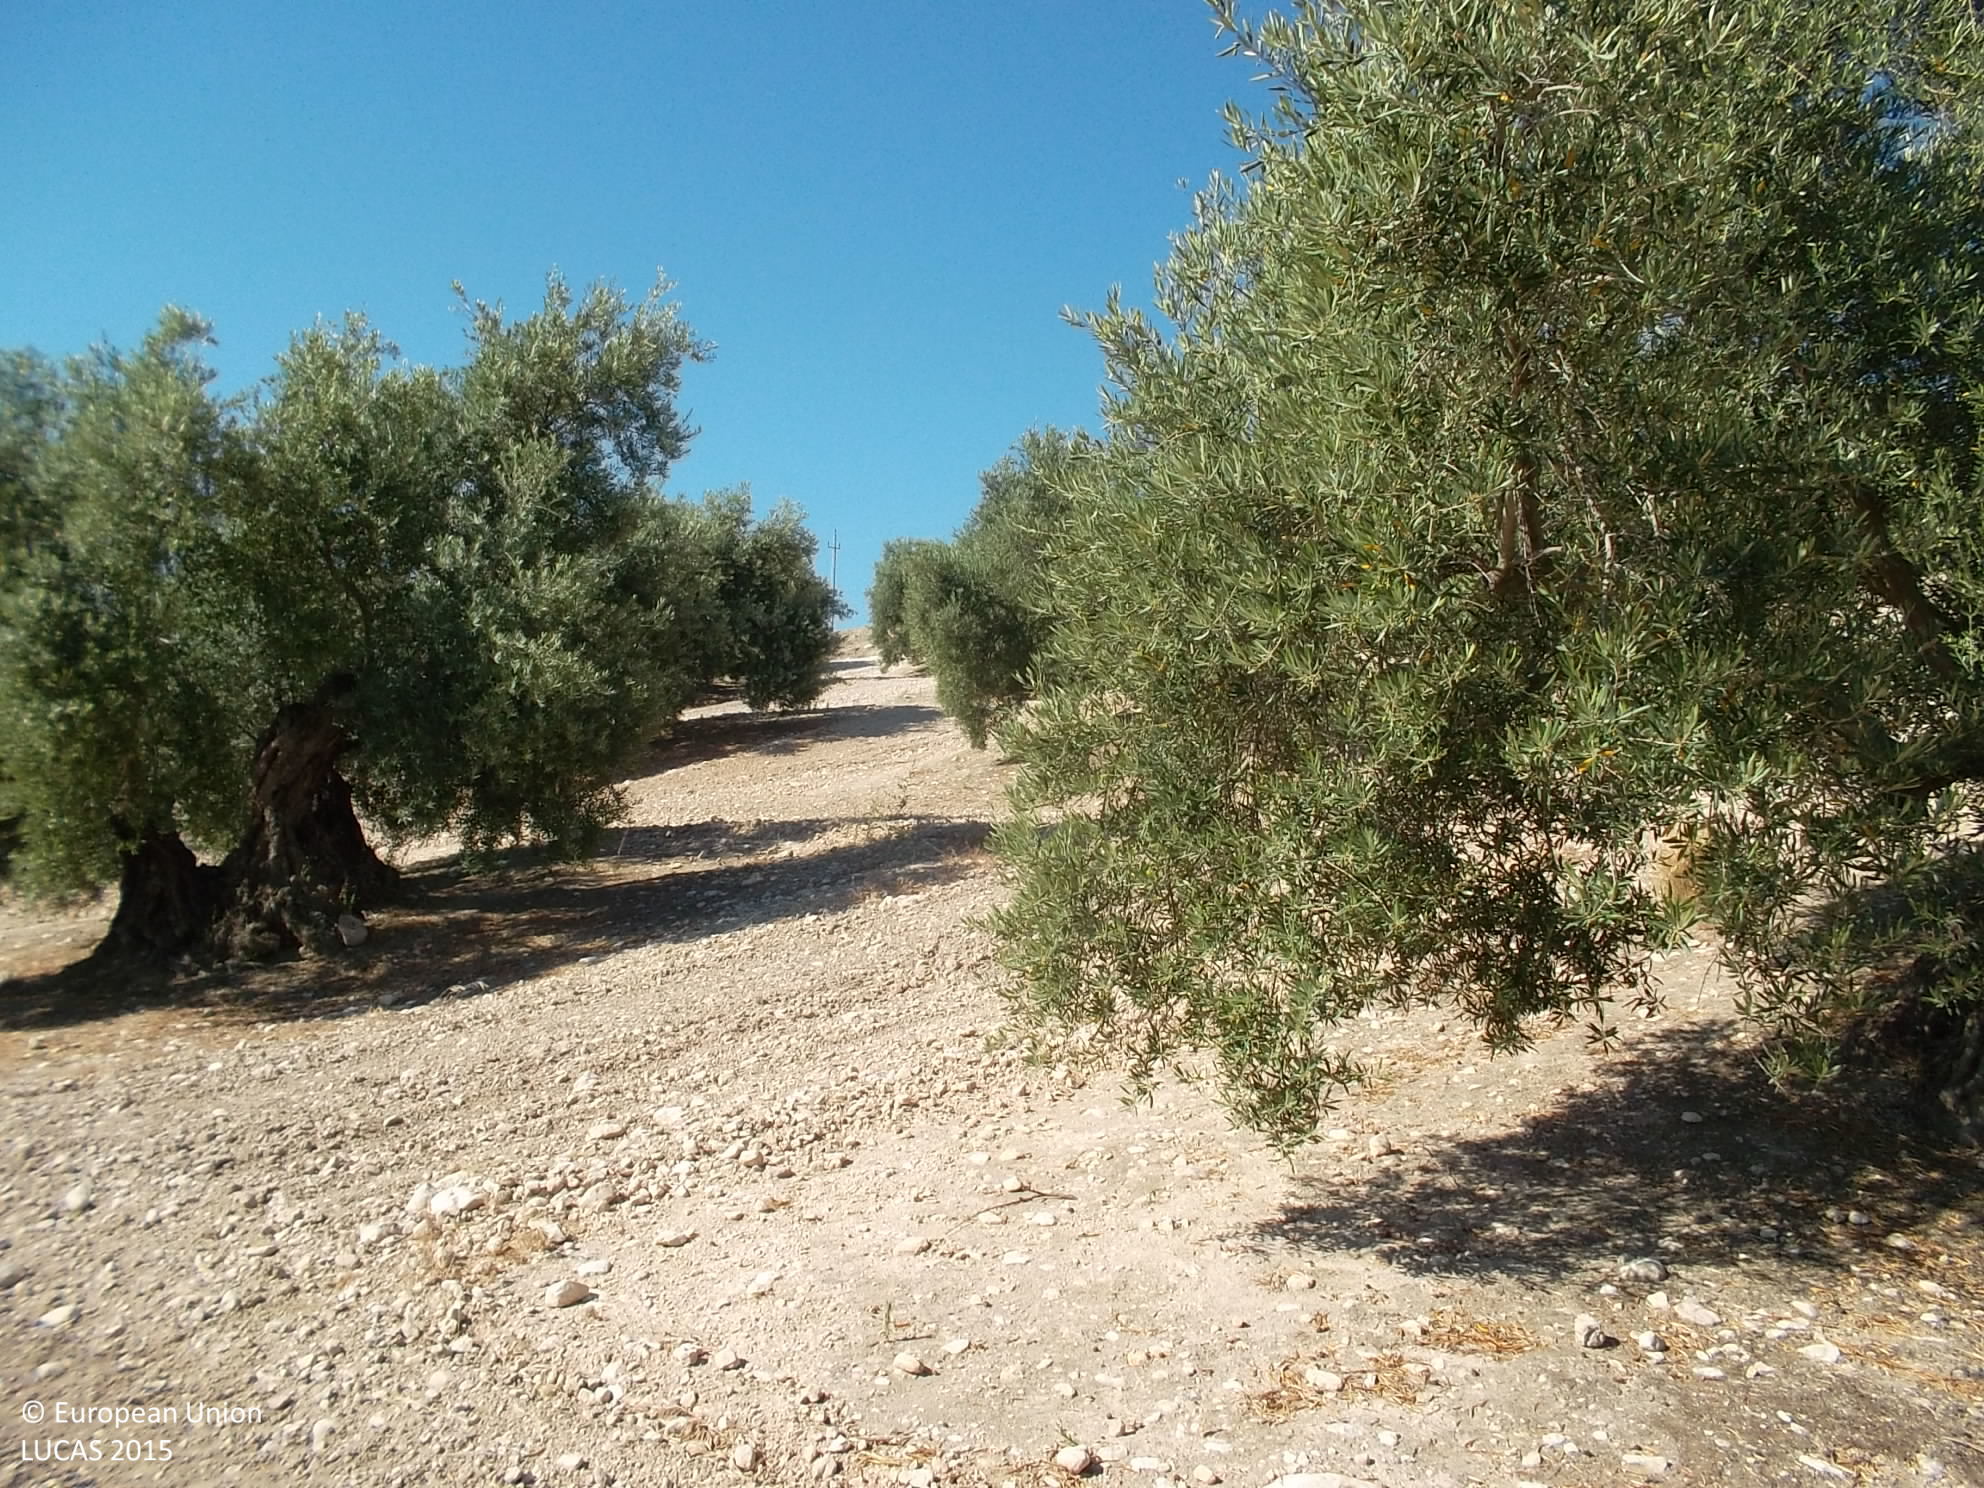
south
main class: Cropland
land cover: Olive groves
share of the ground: 25 - 50 %
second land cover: Other bare soil
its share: > 75 %
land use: Agriculture (excluding fallow land and kitchen gardens)
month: June
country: ES
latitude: 37.8864
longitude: -3.3353
